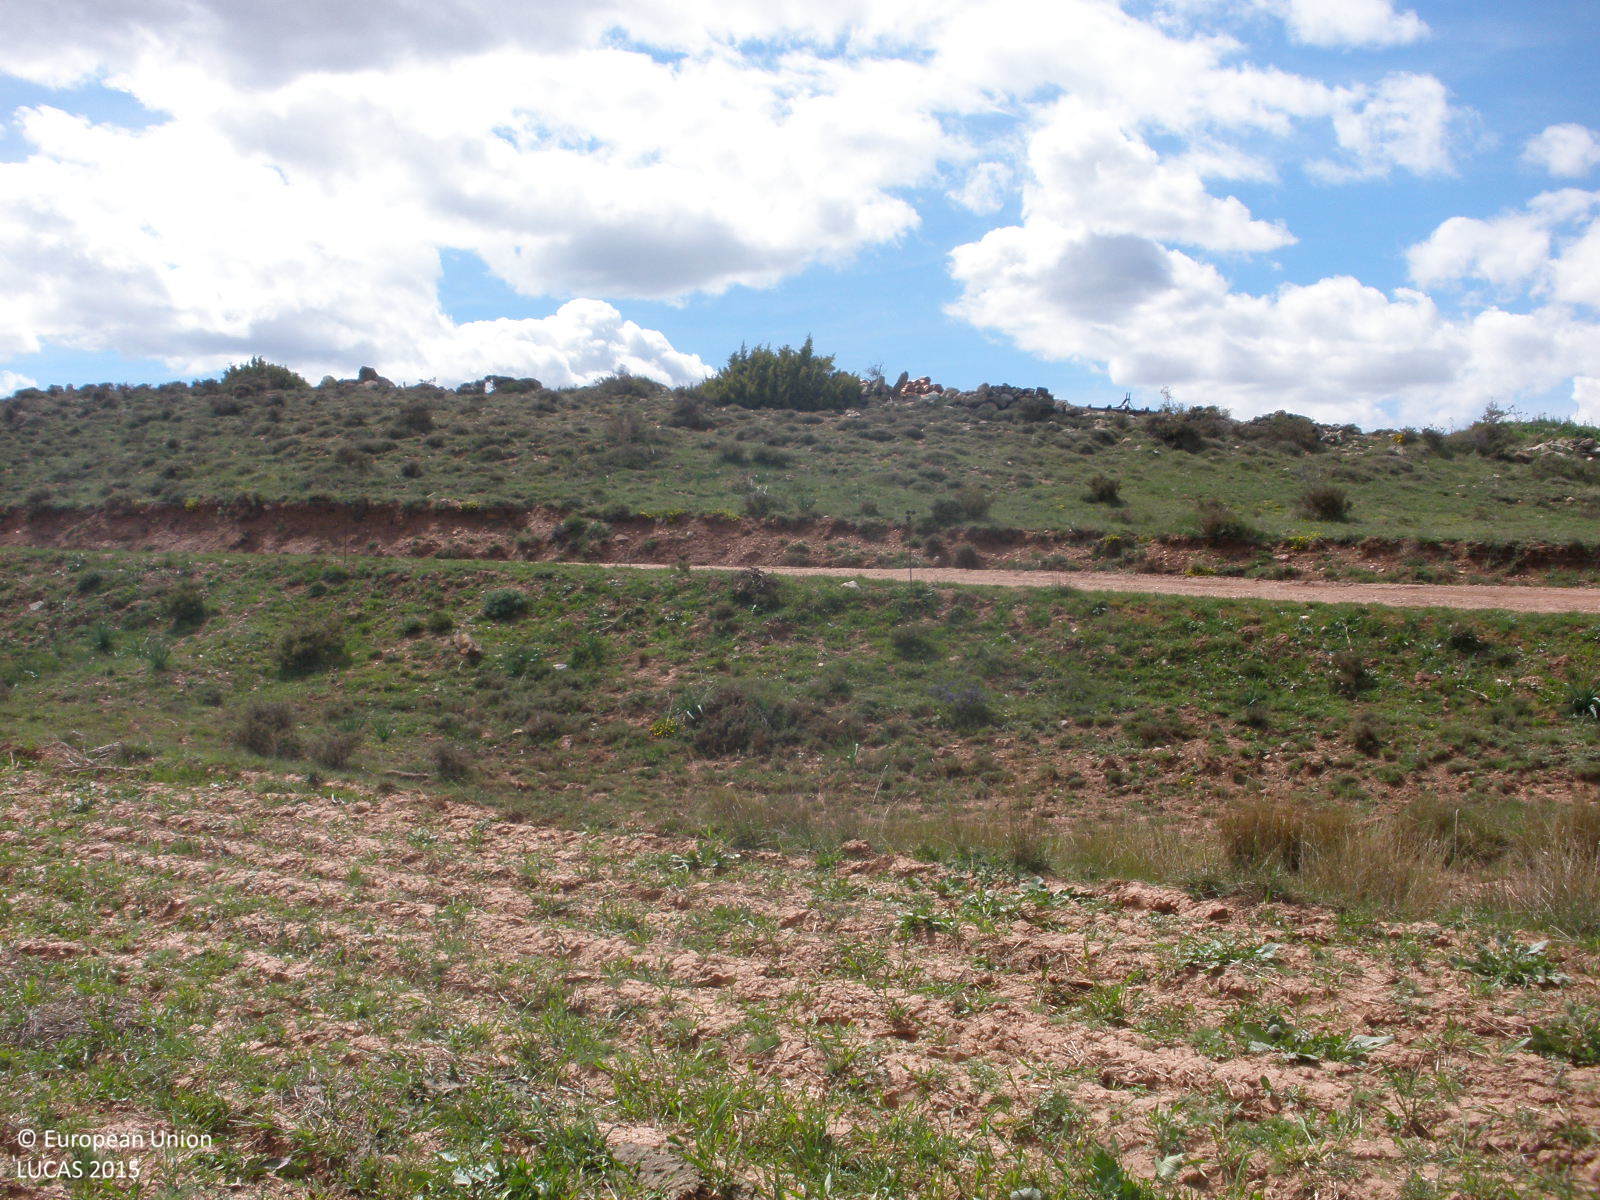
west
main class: Grassland
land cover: Spontaneously vegetated surfaces
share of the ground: 50 - 75 %
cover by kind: herbaceous plants 50 %, unconsolidated bare surface 50 %
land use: Agriculture (excluding fallow land and kitchen gardens)
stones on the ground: < 10 %
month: April
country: ES
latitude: 40.4894
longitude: -0.8052
